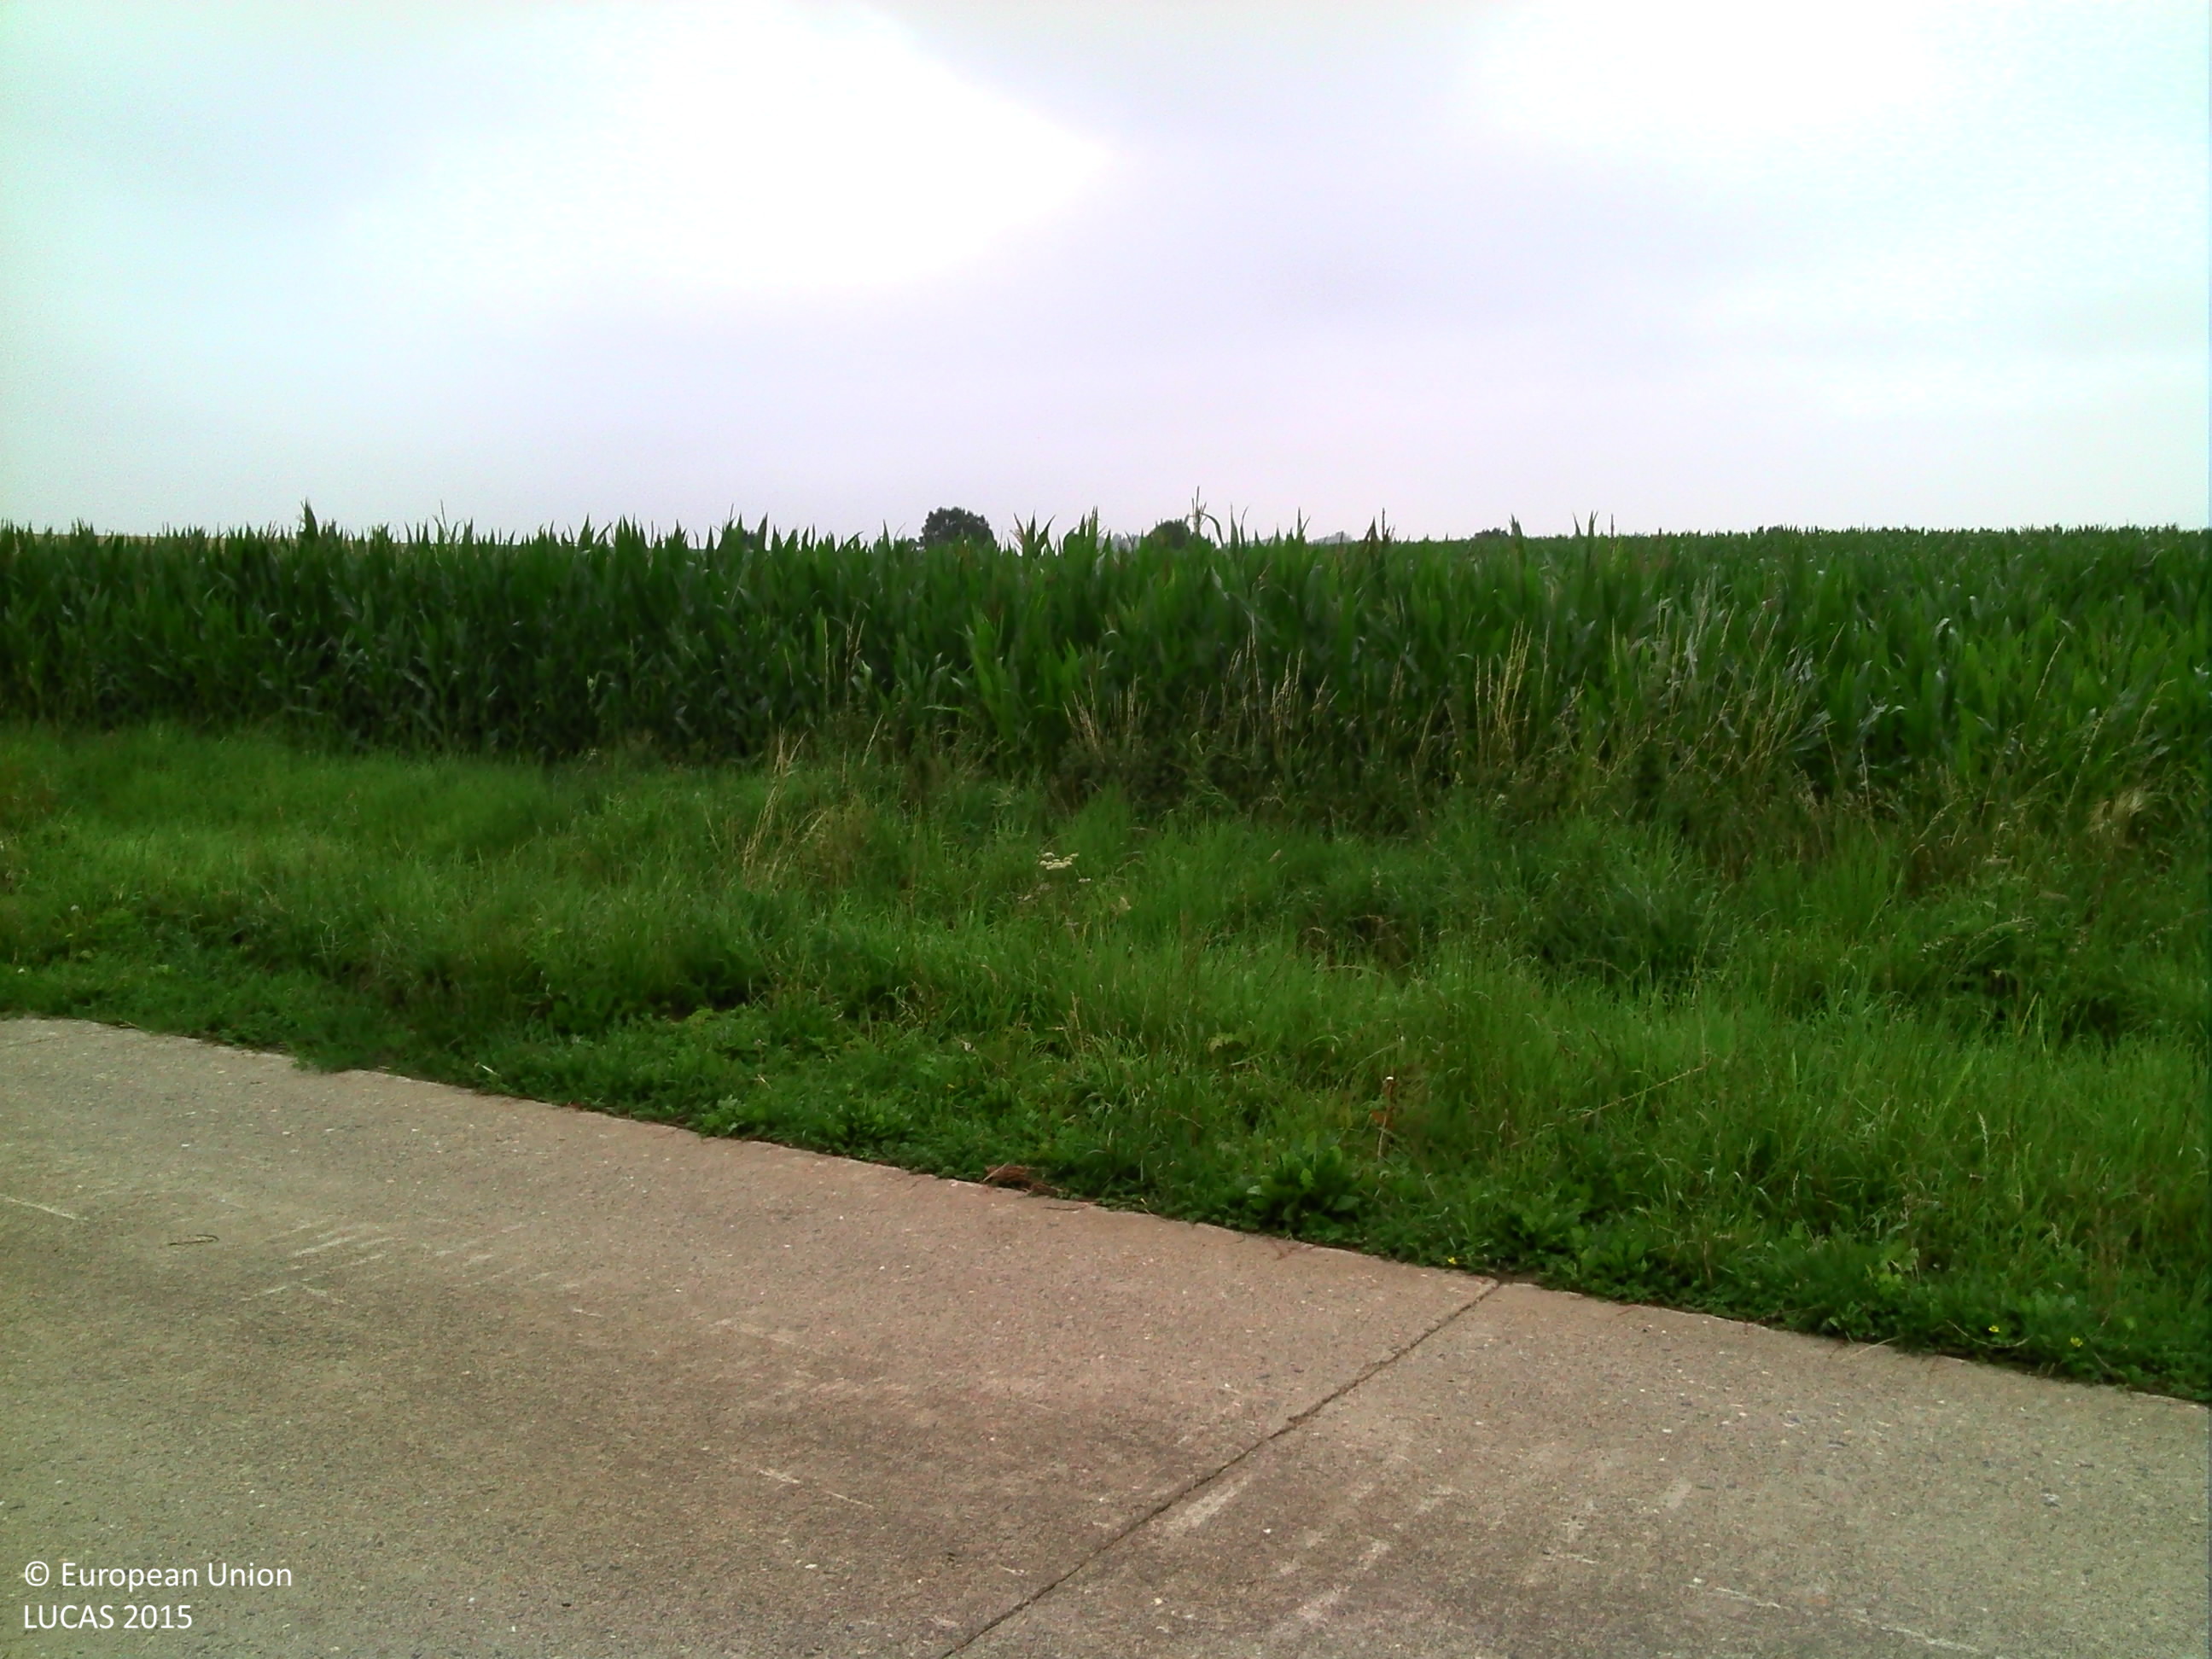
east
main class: Cropland
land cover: Maize
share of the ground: > 75 %
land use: Agriculture (excluding fallow land and kitchen gardens)
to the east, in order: Maize; Grass margins; Paved roads, cycling and walking lanes; Grass margins; Ditches and canals; Grass margins; Maize; Barley; Grass margins; Paved roads, cycling and walking lanes; Lines of trees; Ditches and canals; Grass margins; Fences; Grassland without tree/shrub cover
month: July
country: BE
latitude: 50.8022
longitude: 5.6139
